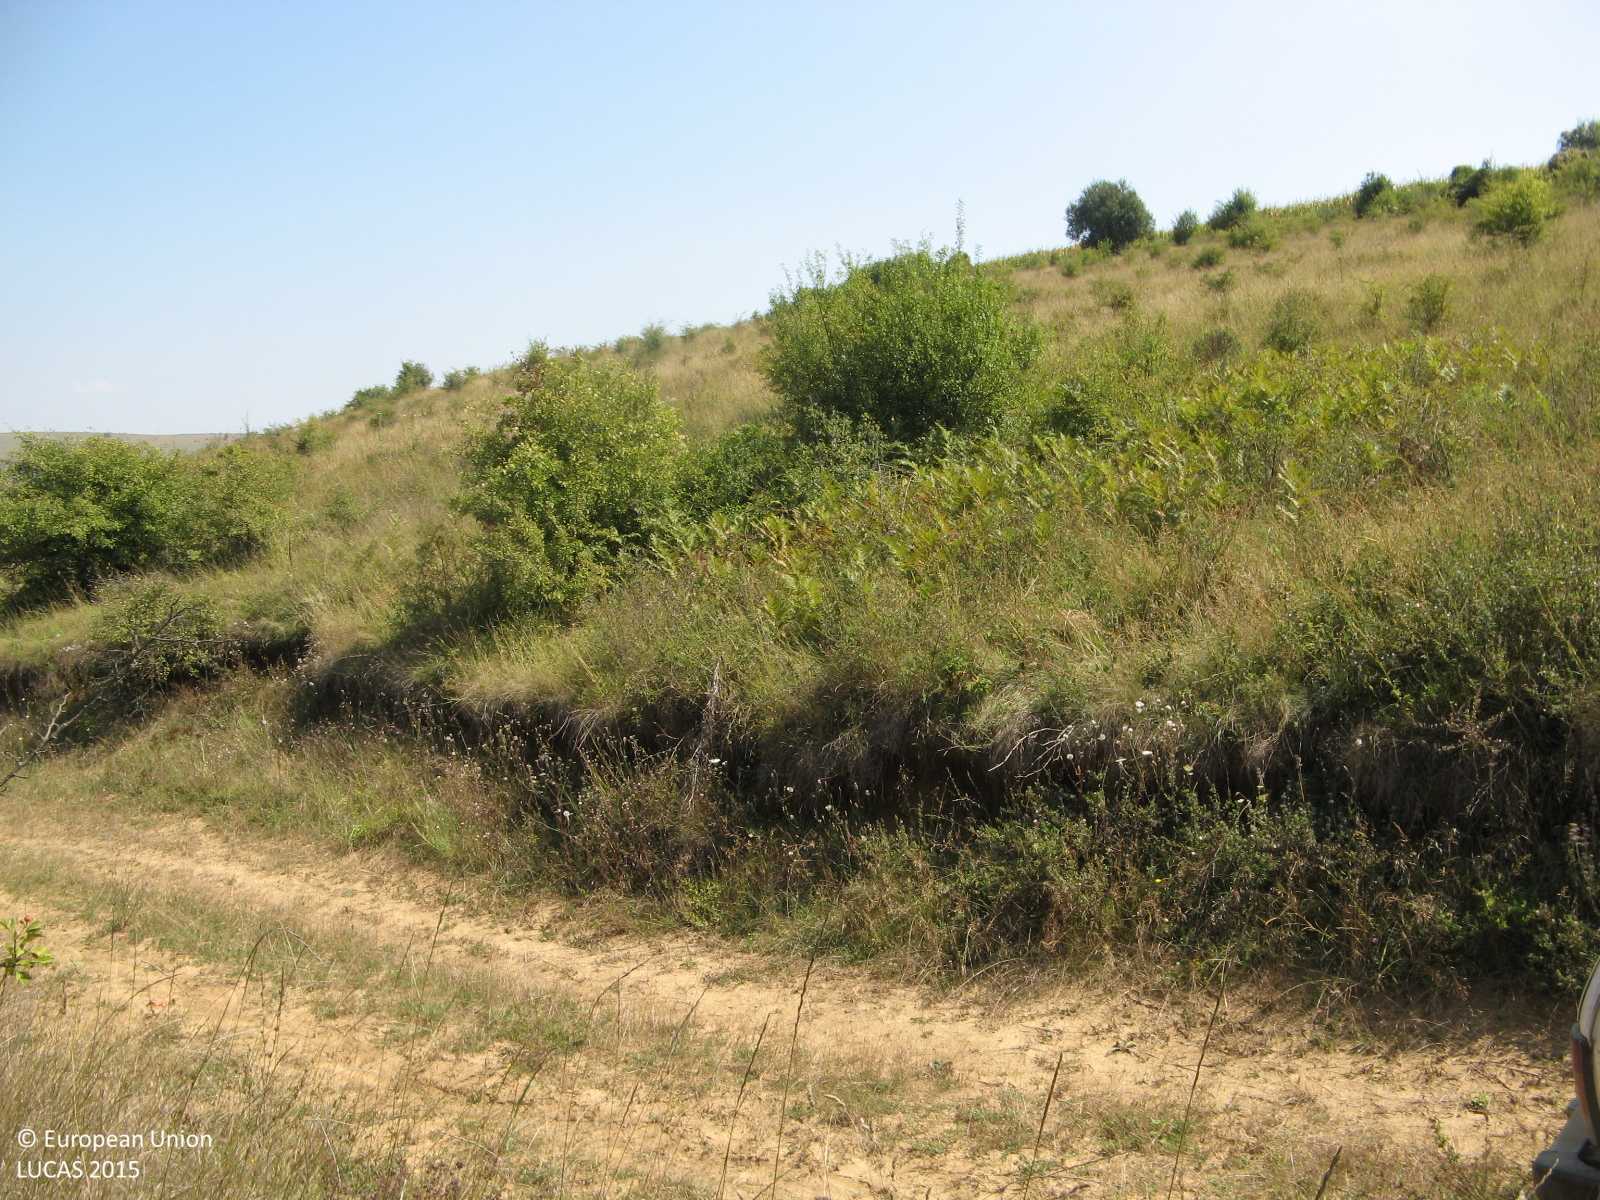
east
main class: Shrubland
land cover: Shrubland with sparse tree cover
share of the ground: > 75 %
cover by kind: shrubs 90 %, broadleaved forest trees 5 %, herbaceous plants 5 %
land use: Semi-natural and natural areas not in use
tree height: > 5 m
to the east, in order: Shrubland with sparse tree cover; Grass margins; Tracks; Grassland with sparse tree/shrub cover
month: August
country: BG
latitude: 43.5069
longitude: 25.8599
